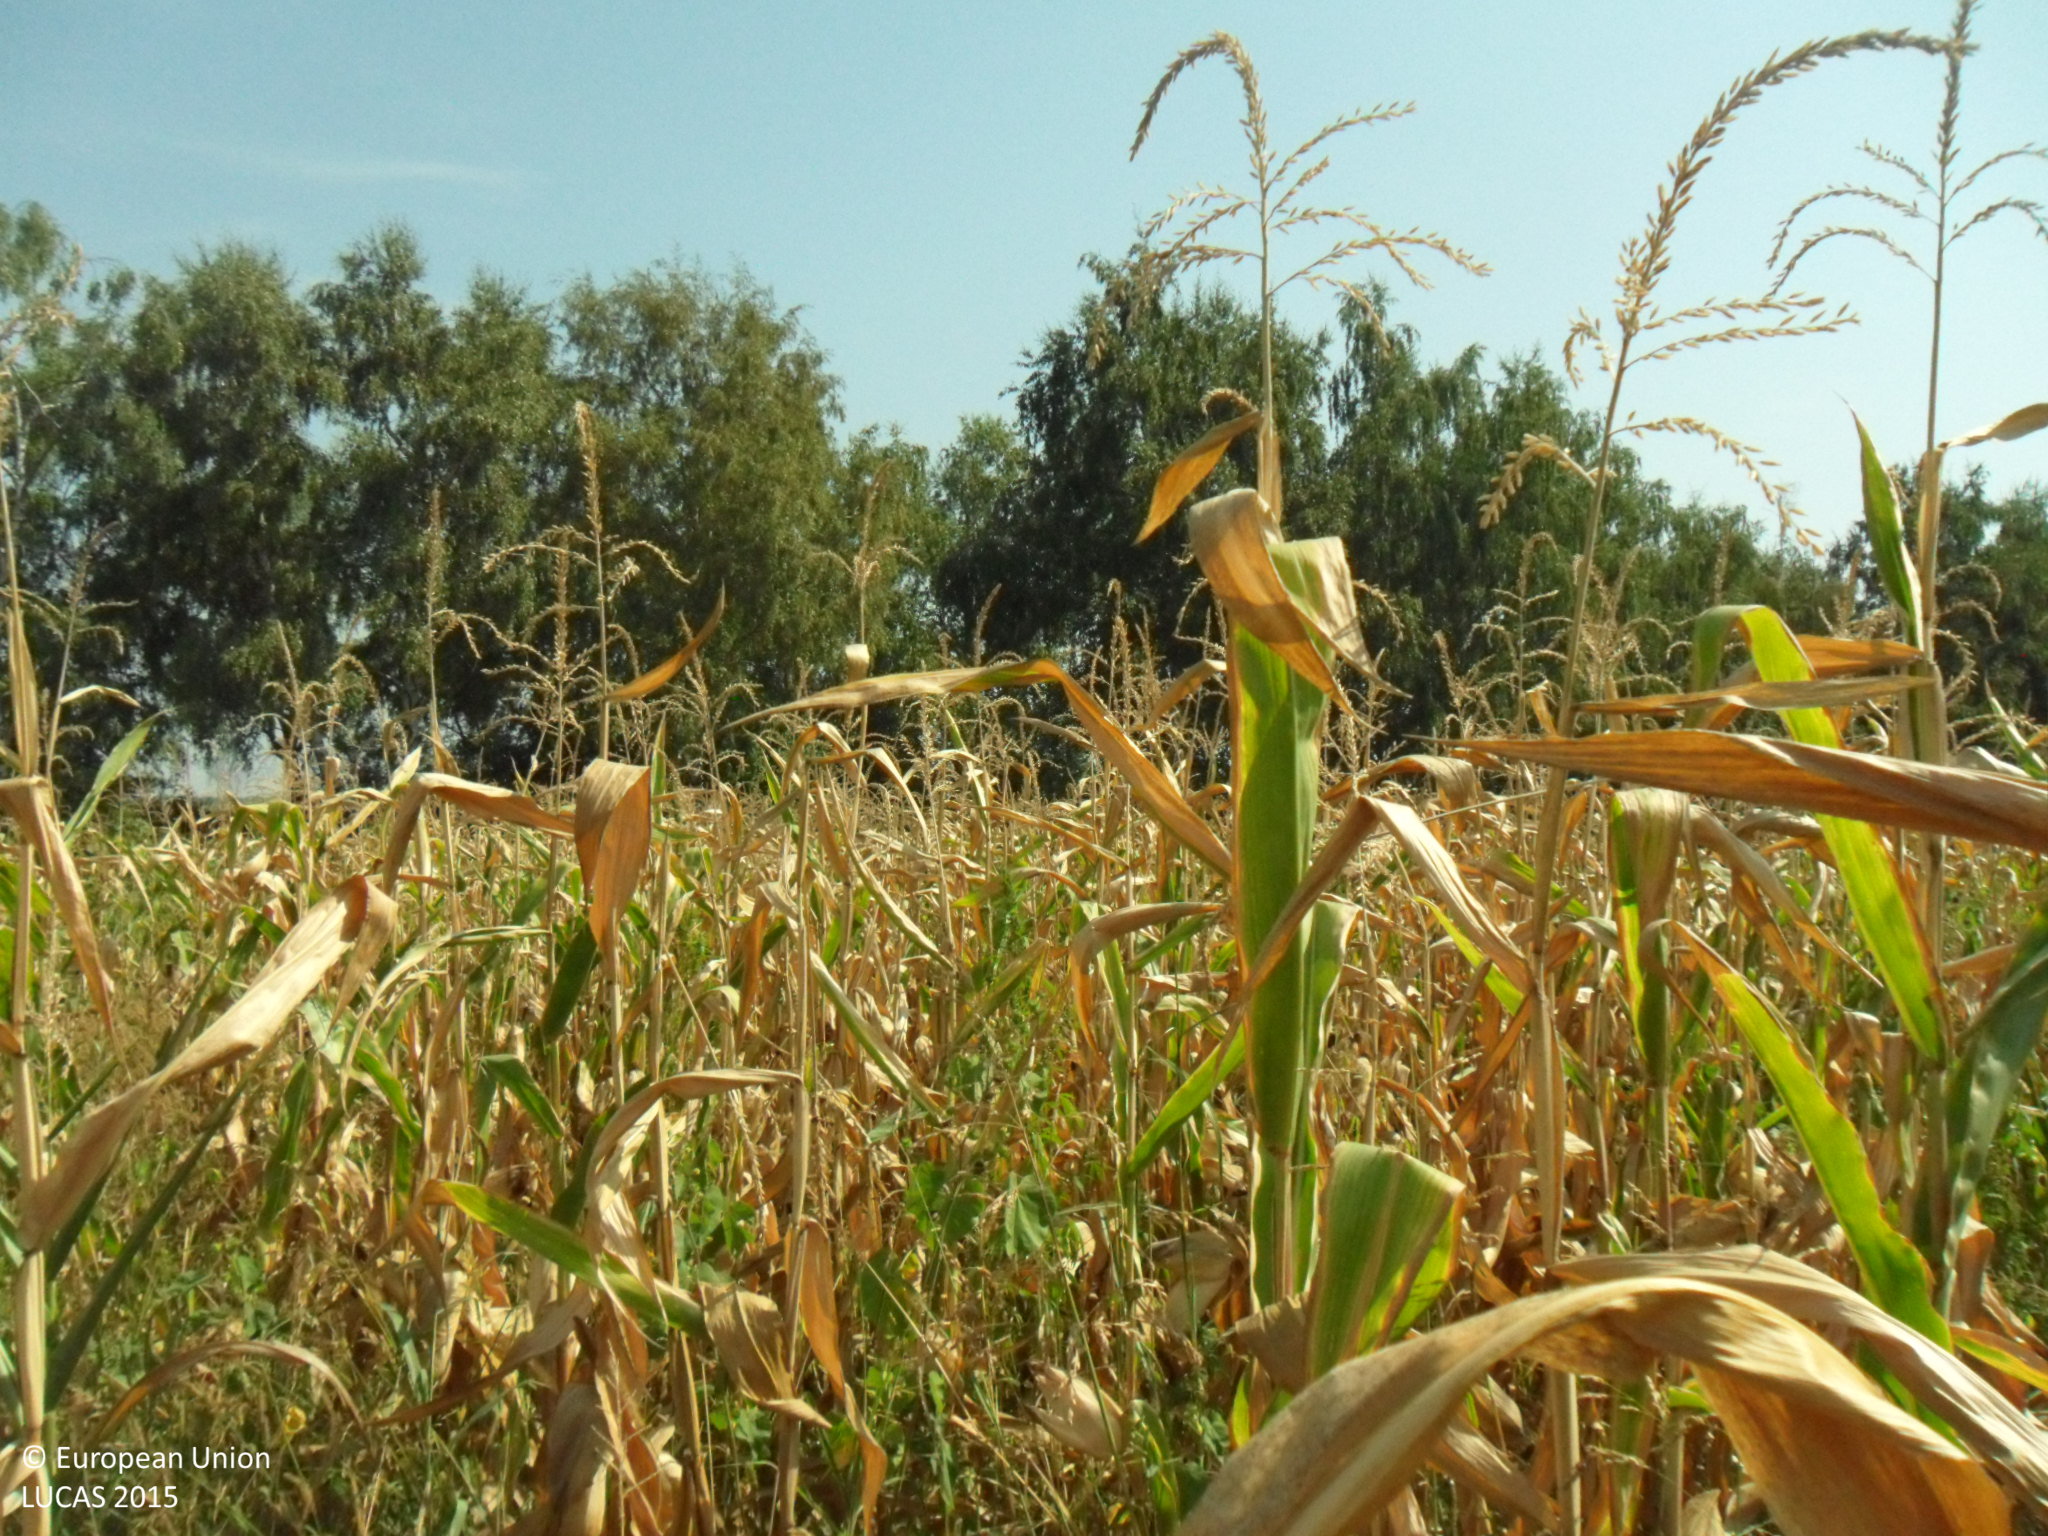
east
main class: Cropland
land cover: Maize
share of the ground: > 75 %
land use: Agriculture (excluding fallow land and kitchen gardens)
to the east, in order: Maize; Grass margins; Lines of trees; Paved roads, cycling and walking lanes; Lines of trees; Other fresh vegetables; Lucerne; Sunflower; Tracks; Grass margins; Maize
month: September
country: BG
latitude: 43.6792
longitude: 26.6197
